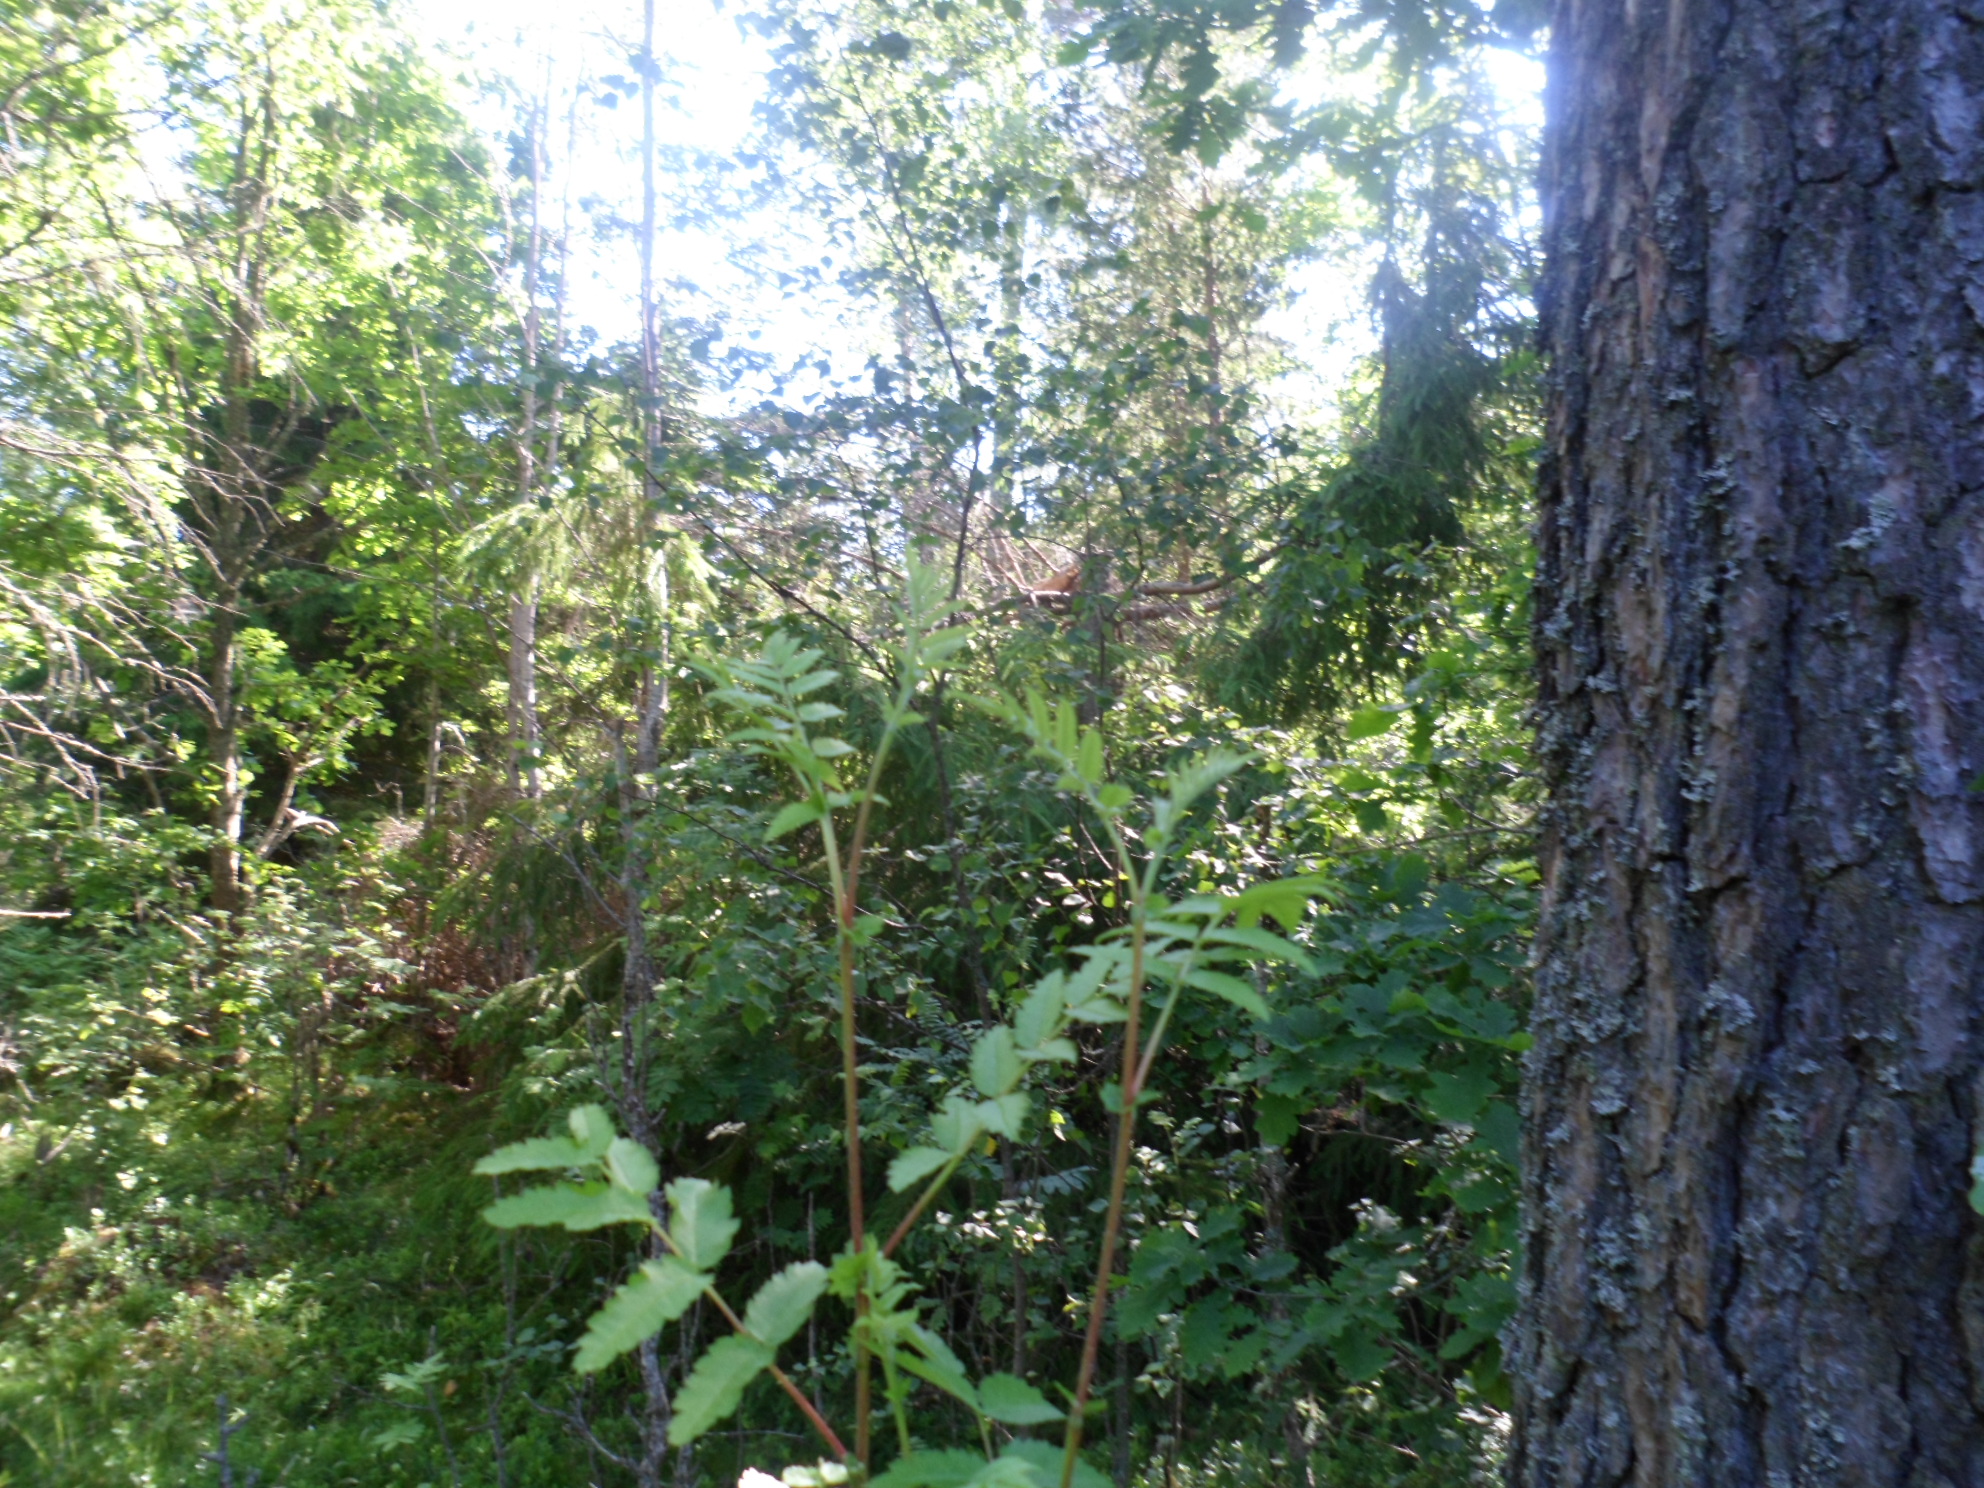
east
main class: Woodland
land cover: Pine dominated mixed woodland
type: boreal forest
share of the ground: 50 - 75 %
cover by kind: coniferous forest trees 30 %, broadleaved forest trees 30 %, herbaceous plants 20 %, shrubs 10 %, lichens and mosses 10 %
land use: Forestry
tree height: > 5 m
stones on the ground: 25 - 50 %
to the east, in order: Pine dominated mixed woodland; Spruce dominated mixed woodland; Pine dominated mixed woodland; Paved roads, cycling and walking lanes; Spruce dominated mixed woodland; Grass margins; Ditches and canals; Grassland without tree/shrub cover; Paved roads, cycling and walking lanes; Grass margins; Ditches and canals; Grassland without tree/shrub cover; Spruce dominated mixed woodland
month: July
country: SE
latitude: 57.3157
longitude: 14.4956
